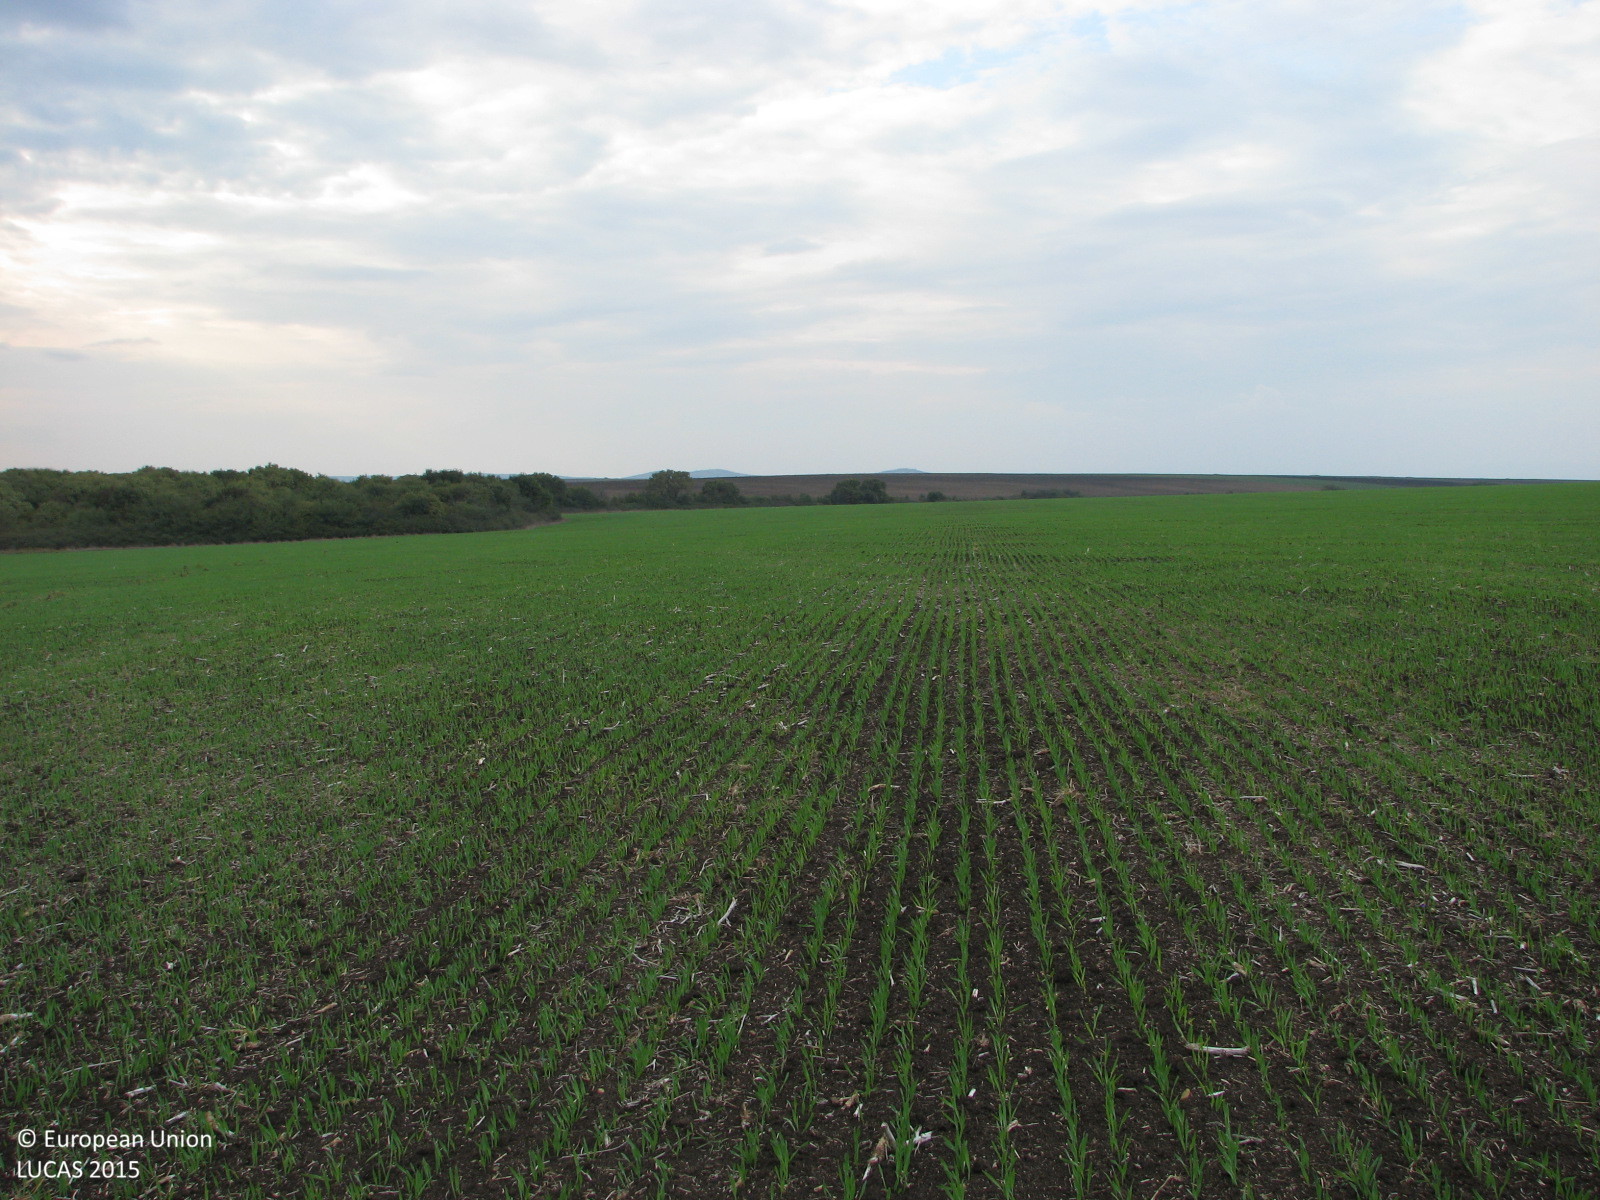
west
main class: Cropland
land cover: Common wheat
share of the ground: 10 - 25 %
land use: Agriculture (excluding fallow land and kitchen gardens)
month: October
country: BG
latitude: 42.2876
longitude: 26.4732
